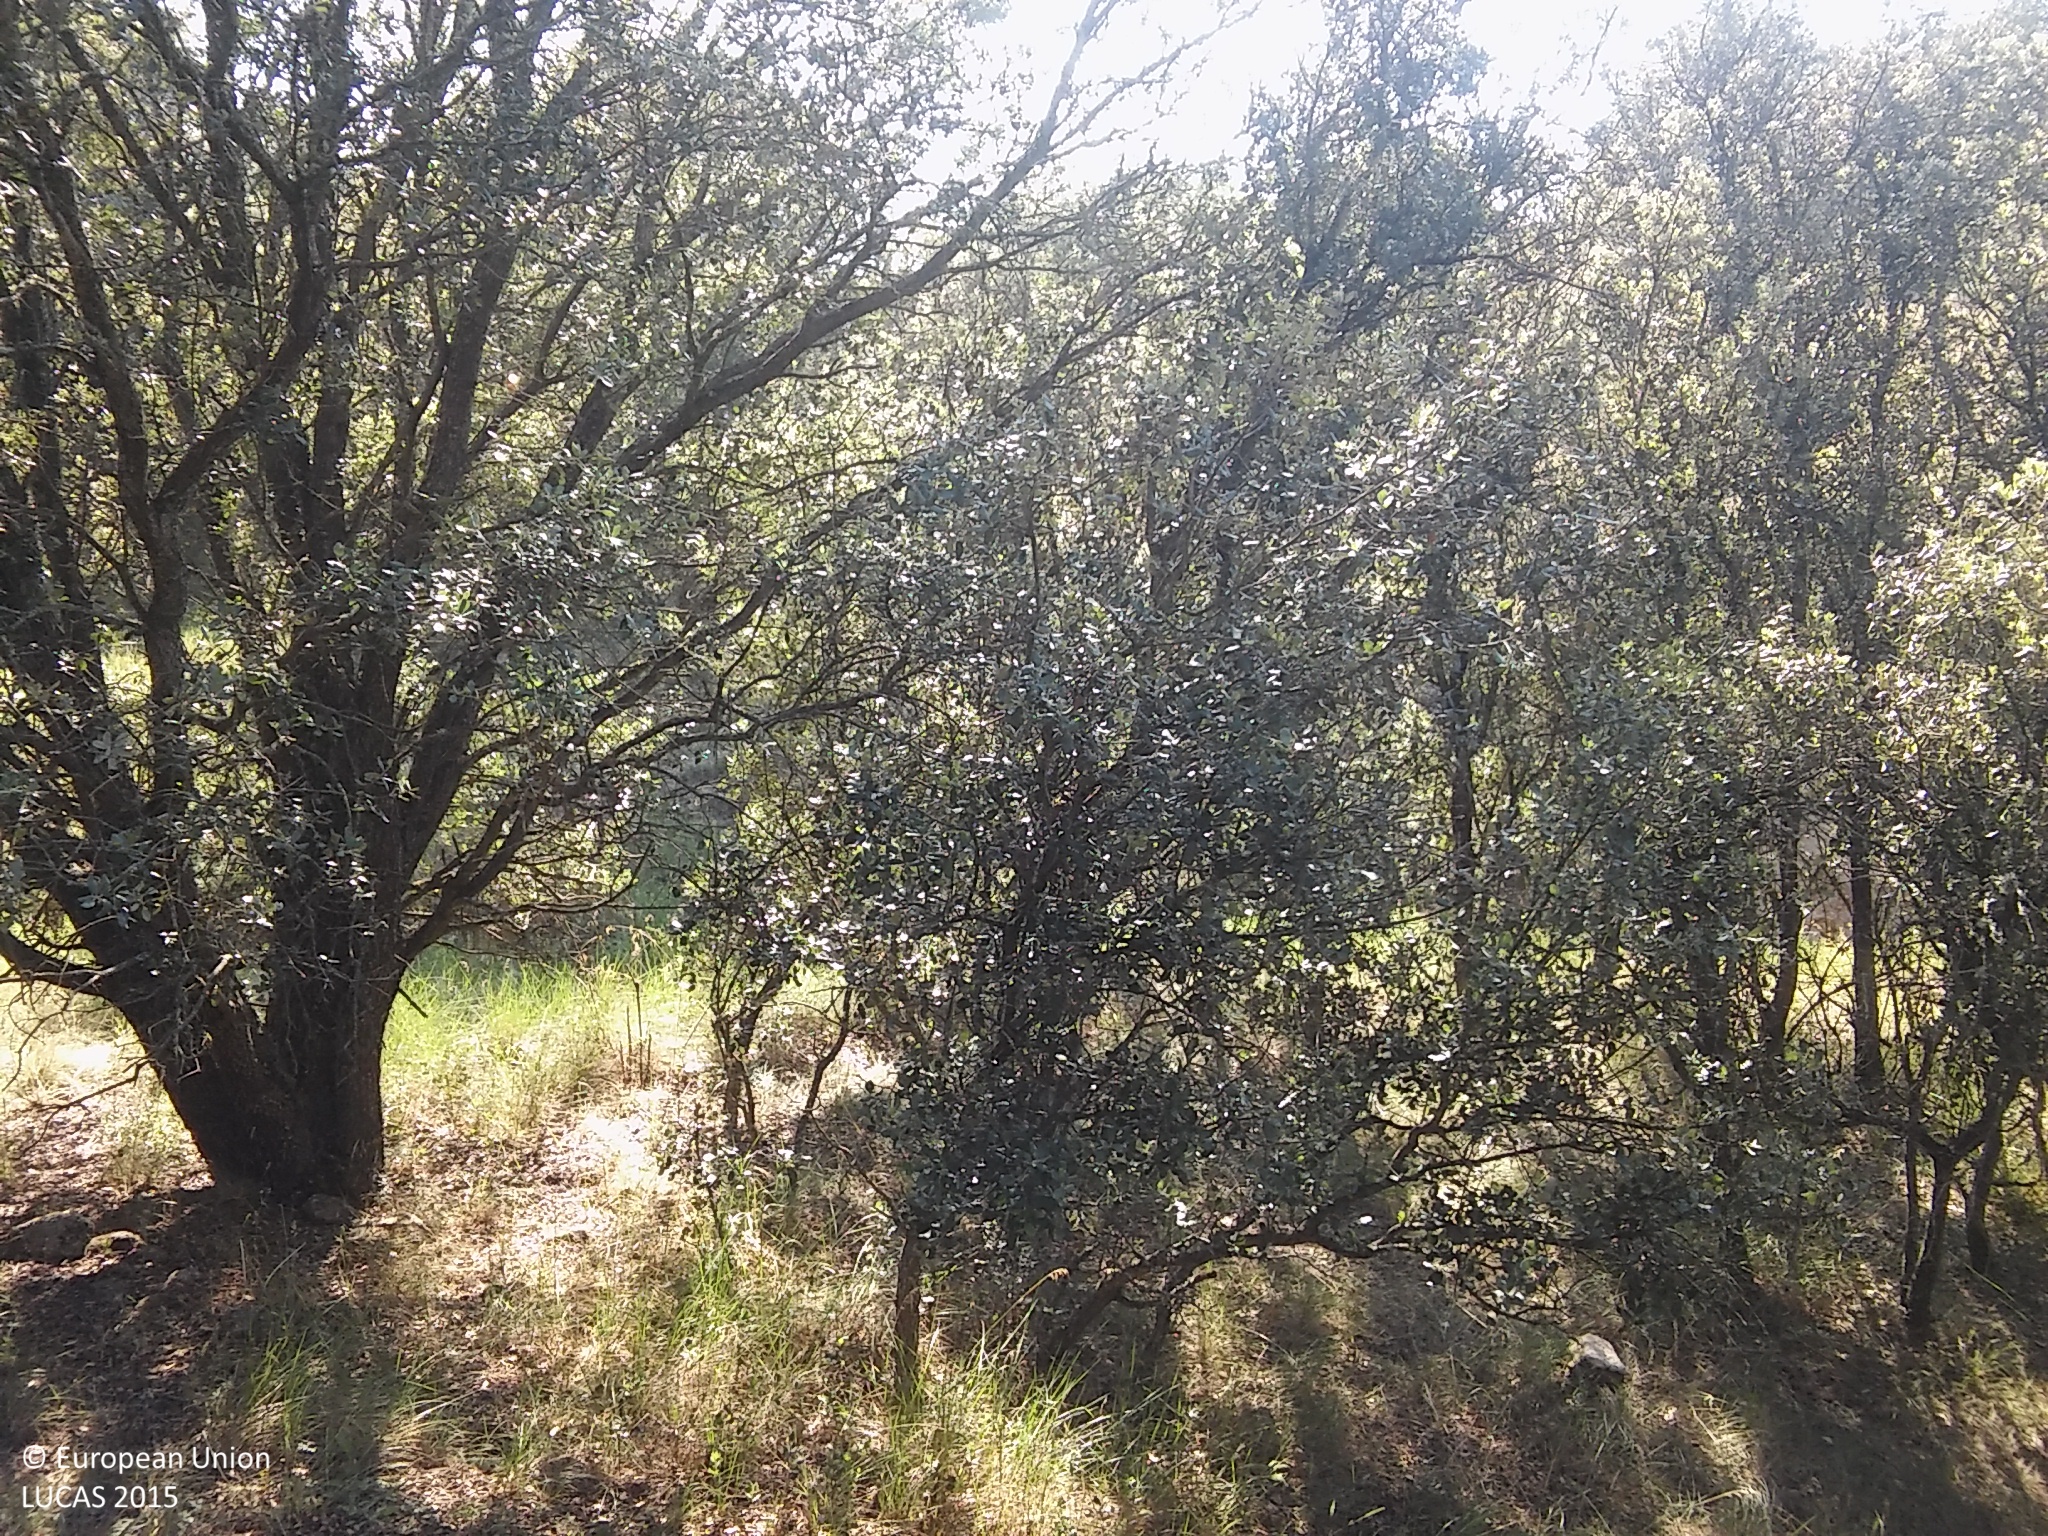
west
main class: Woodland
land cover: Broadleaved woodland
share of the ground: 50 - 75 %
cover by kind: broadleaved forest trees 55 %, herbaceous plants 35 %, shrubs 10 %
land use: Forestry
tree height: > 5 m
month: June
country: ES
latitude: 41.1171
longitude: -4.0693
